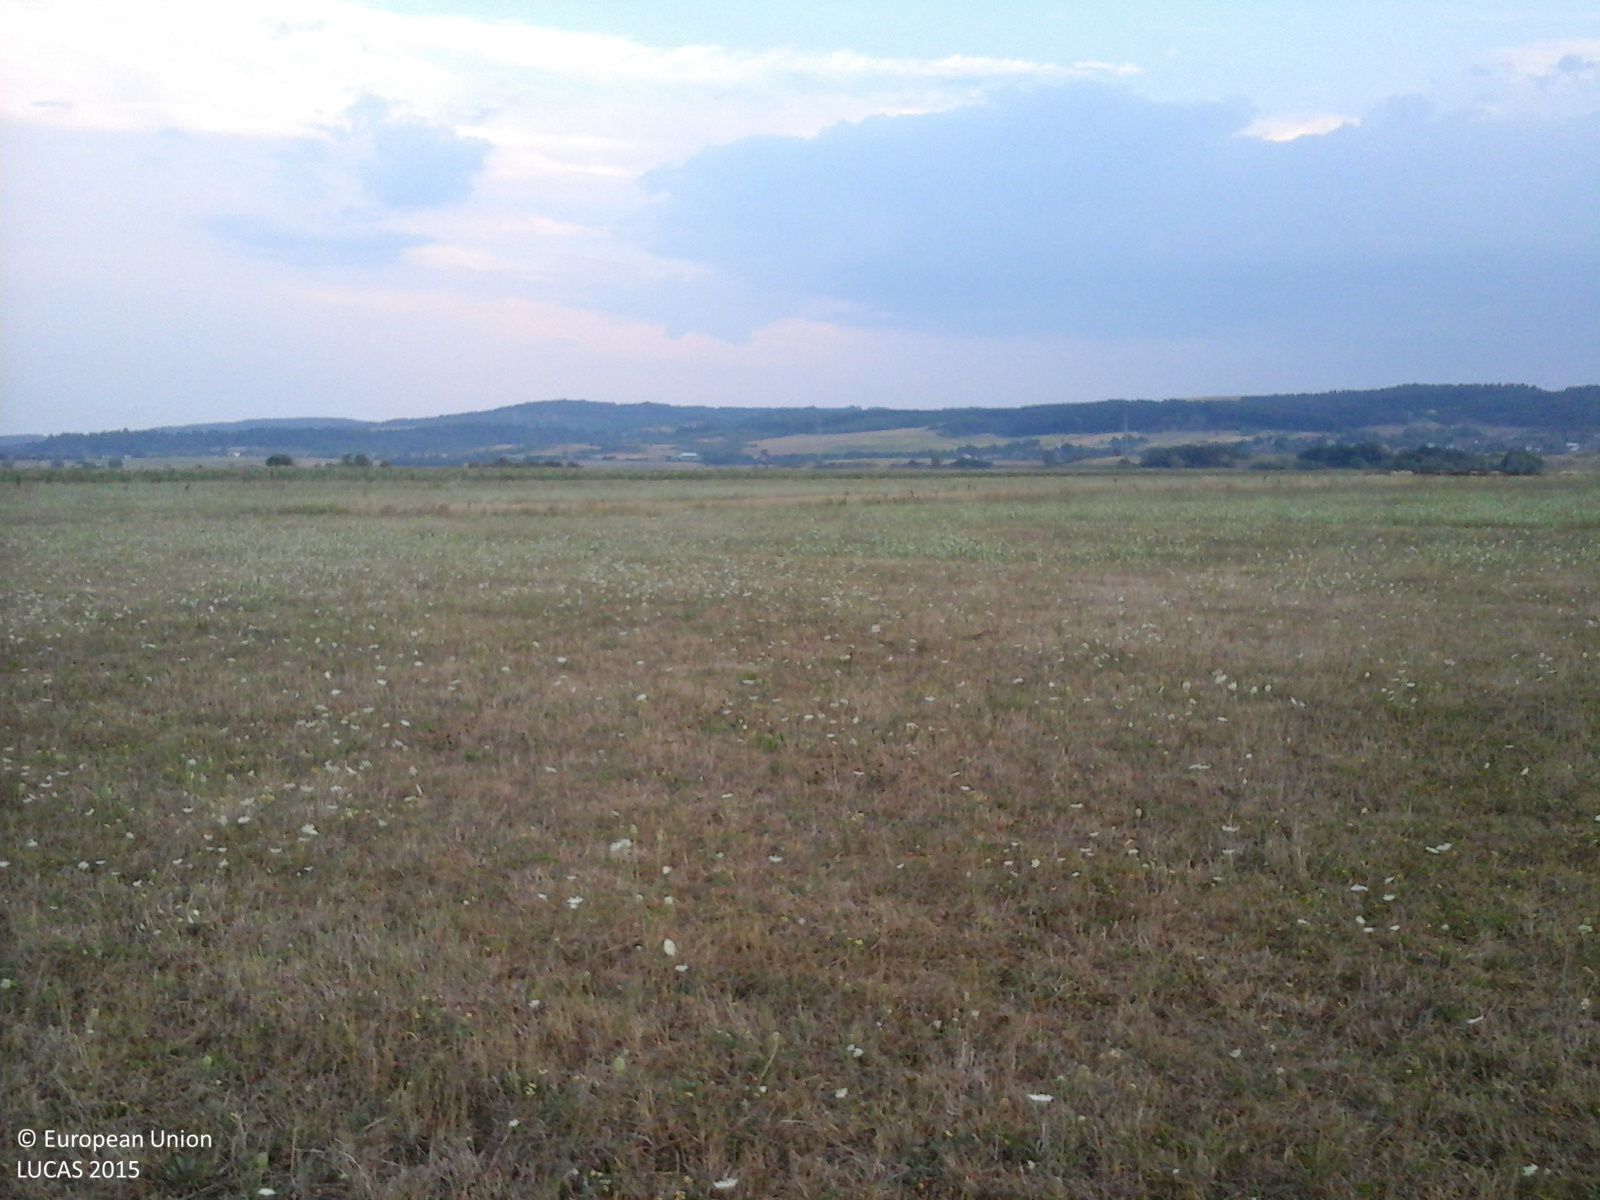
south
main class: Grassland
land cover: Grassland without tree/shrub cover
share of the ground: > 75 %
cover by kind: herbaceous plants 100 %
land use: Agriculture (excluding fallow land and kitchen gardens)
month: August
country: RO
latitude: 44.6801
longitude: 23.1316
